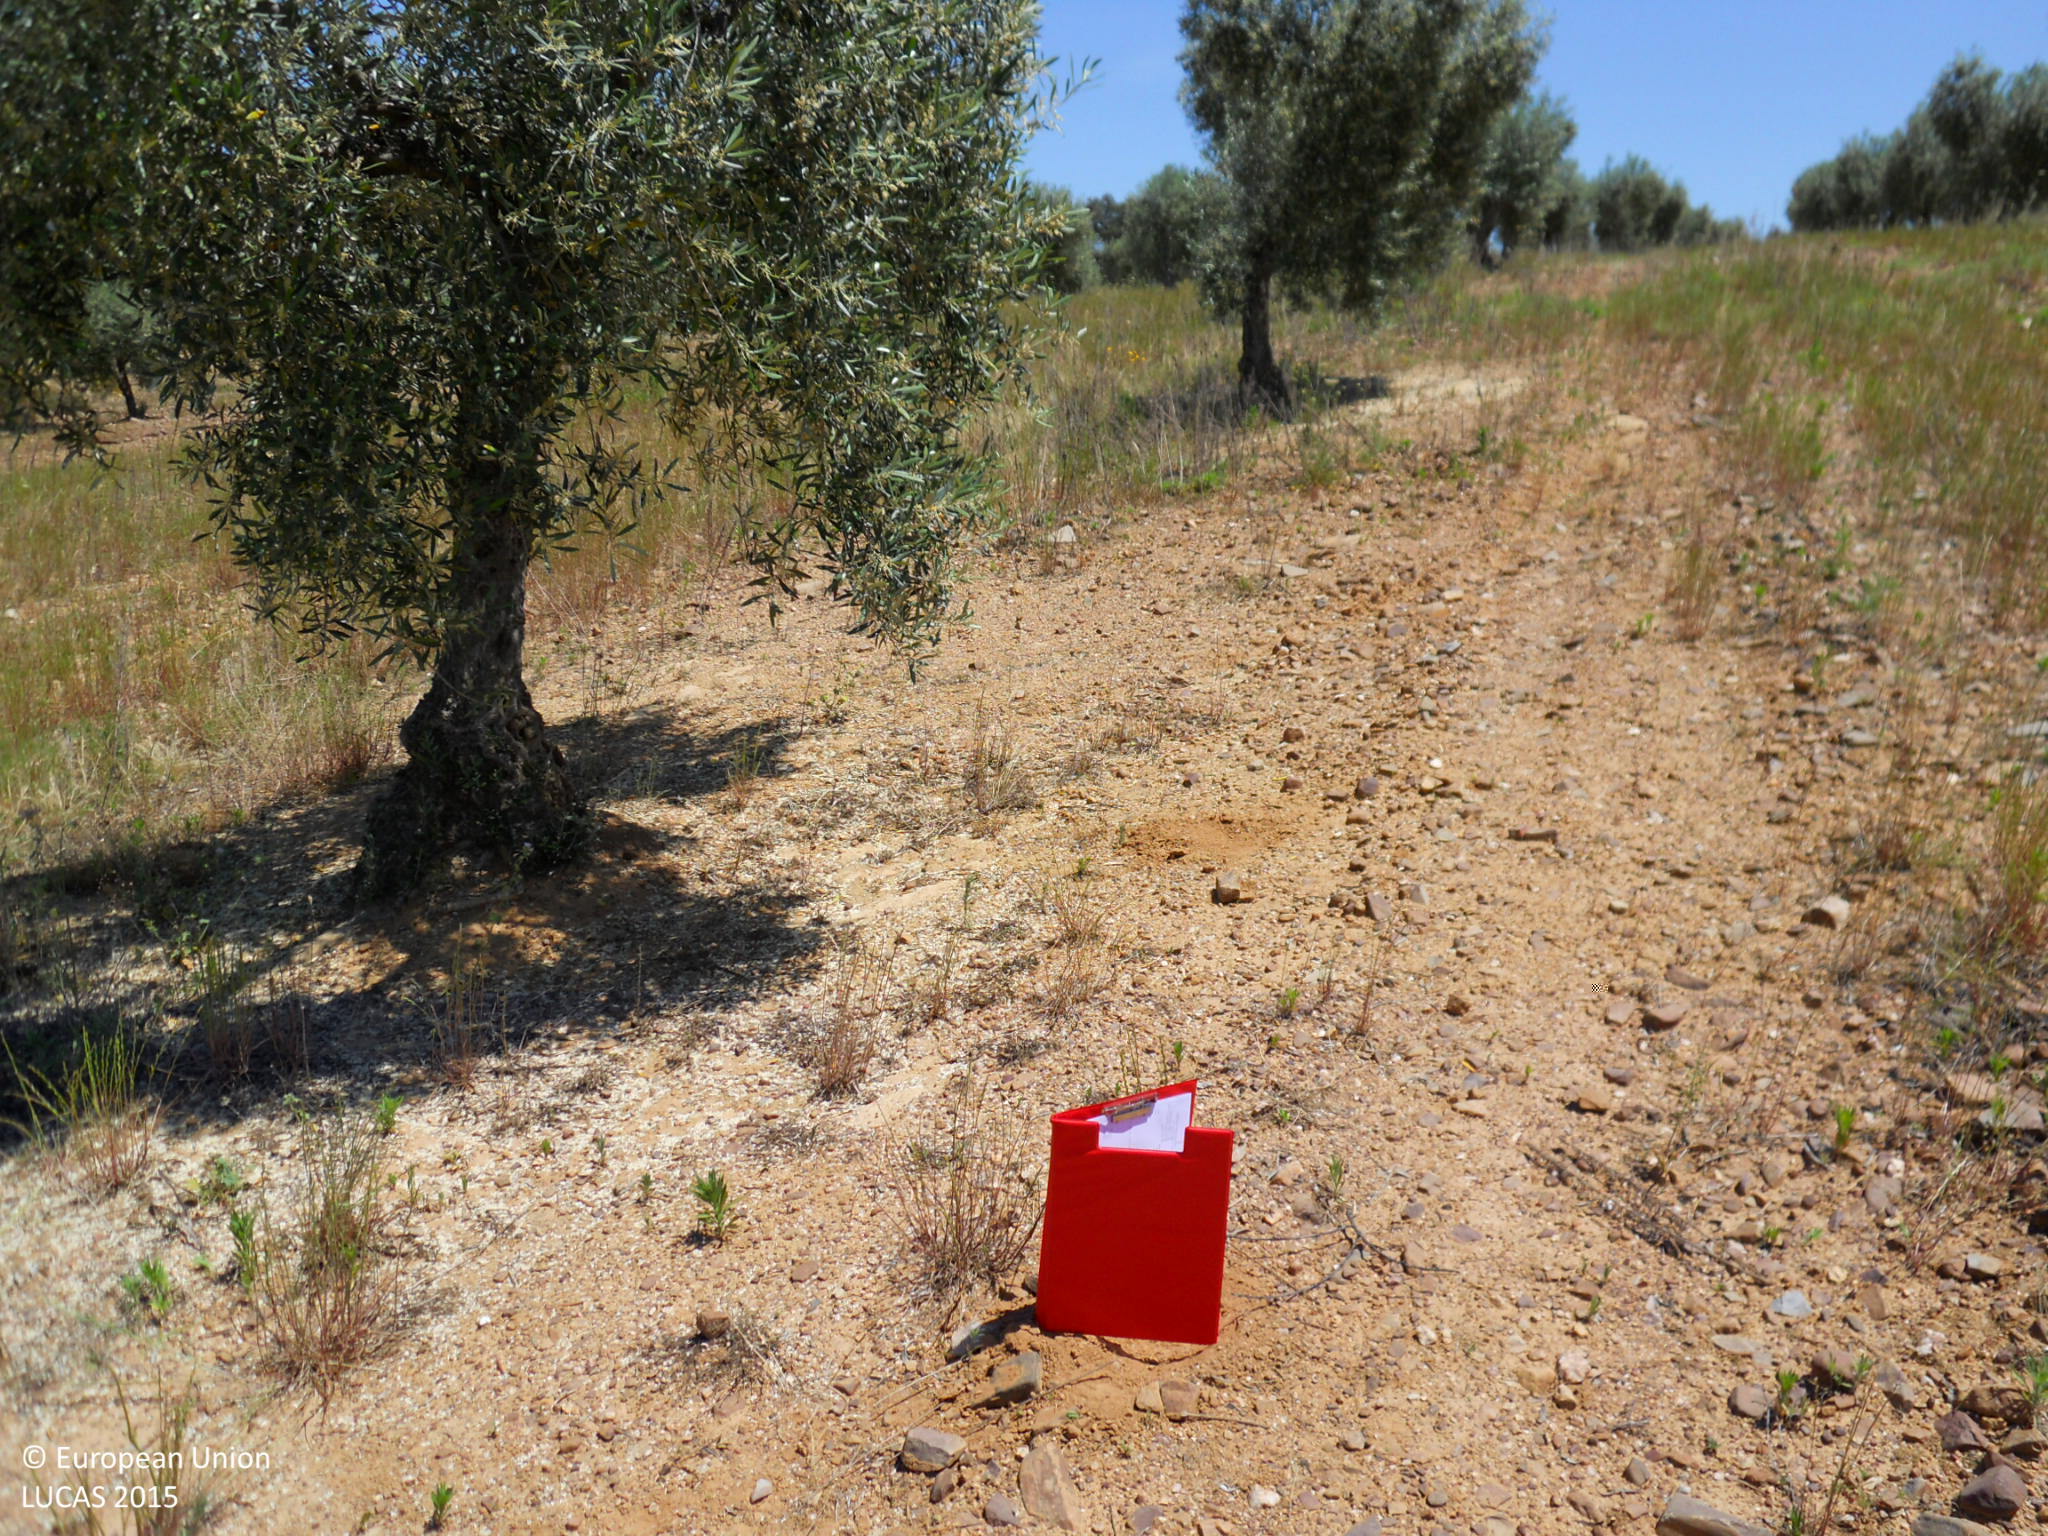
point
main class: Cropland
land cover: Olive groves
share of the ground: > 75 %
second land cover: Spontaneously vegetated surfaces
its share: 25 - 50 %
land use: Agriculture (excluding fallow land and kitchen gardens)
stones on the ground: > 50 %
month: May
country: ES
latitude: 38.9934
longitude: -6.2558
